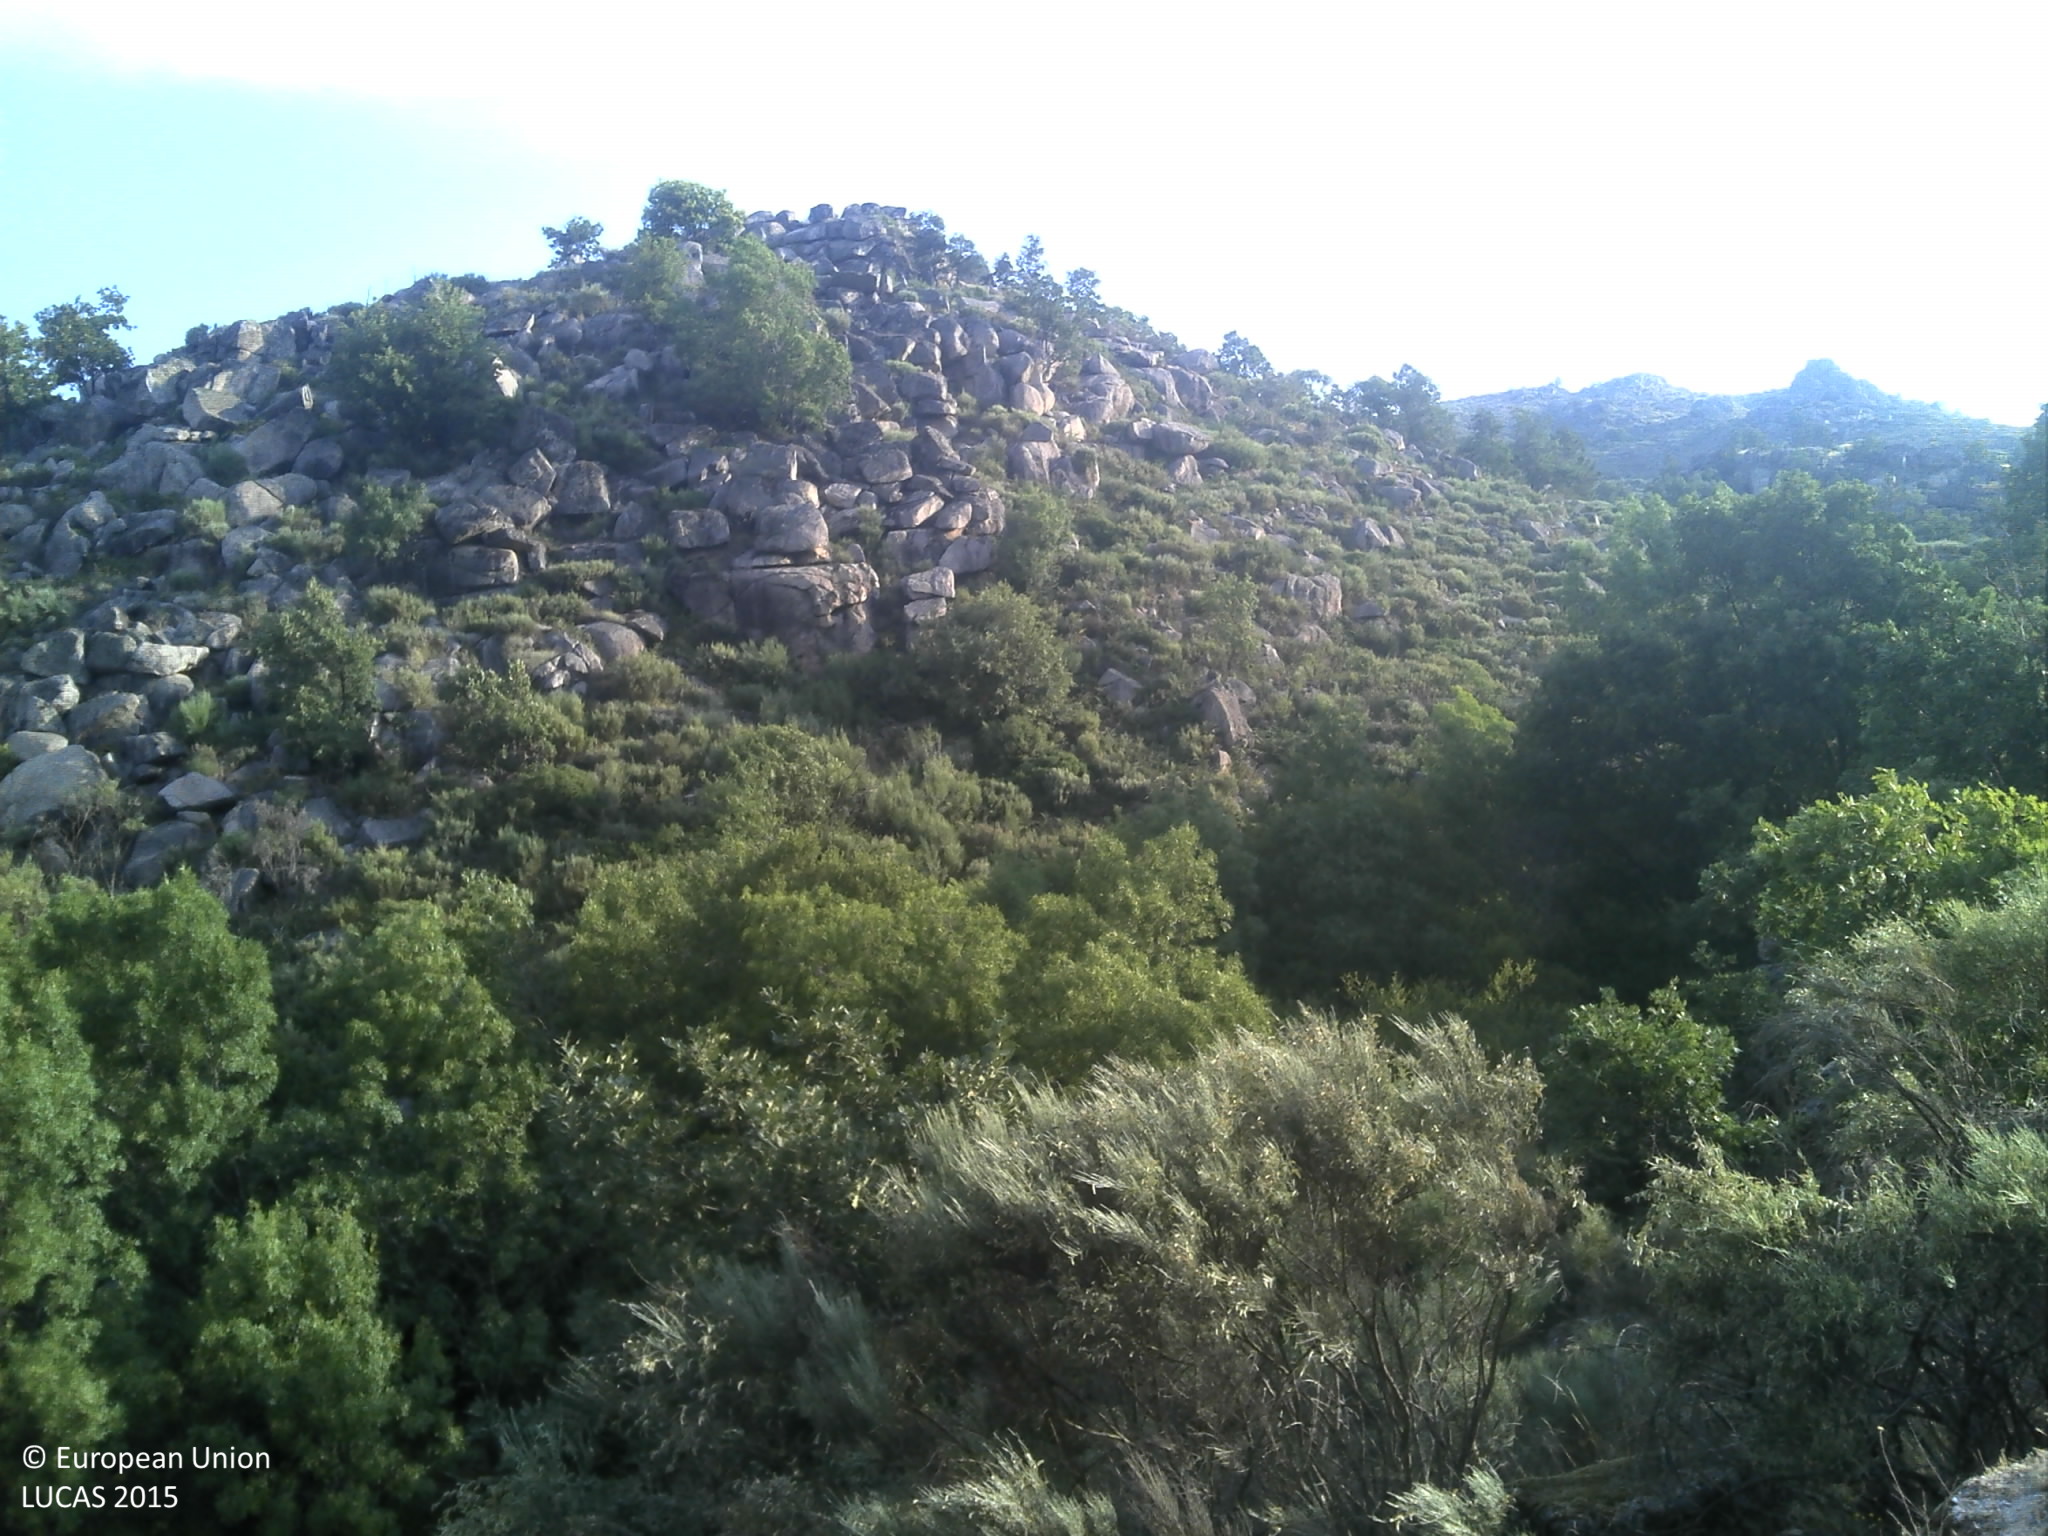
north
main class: Shrubland
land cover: Shrubland without tree cover
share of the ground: 25 - 50 %
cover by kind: shrubs 40 %, unconsolidated bare surface 20 %, herbaceous plants 15 %, consolidated bare surface 15 %
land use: Semi-natural and natural areas not in use
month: June
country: PT
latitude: 40.3784
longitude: -7.1920
